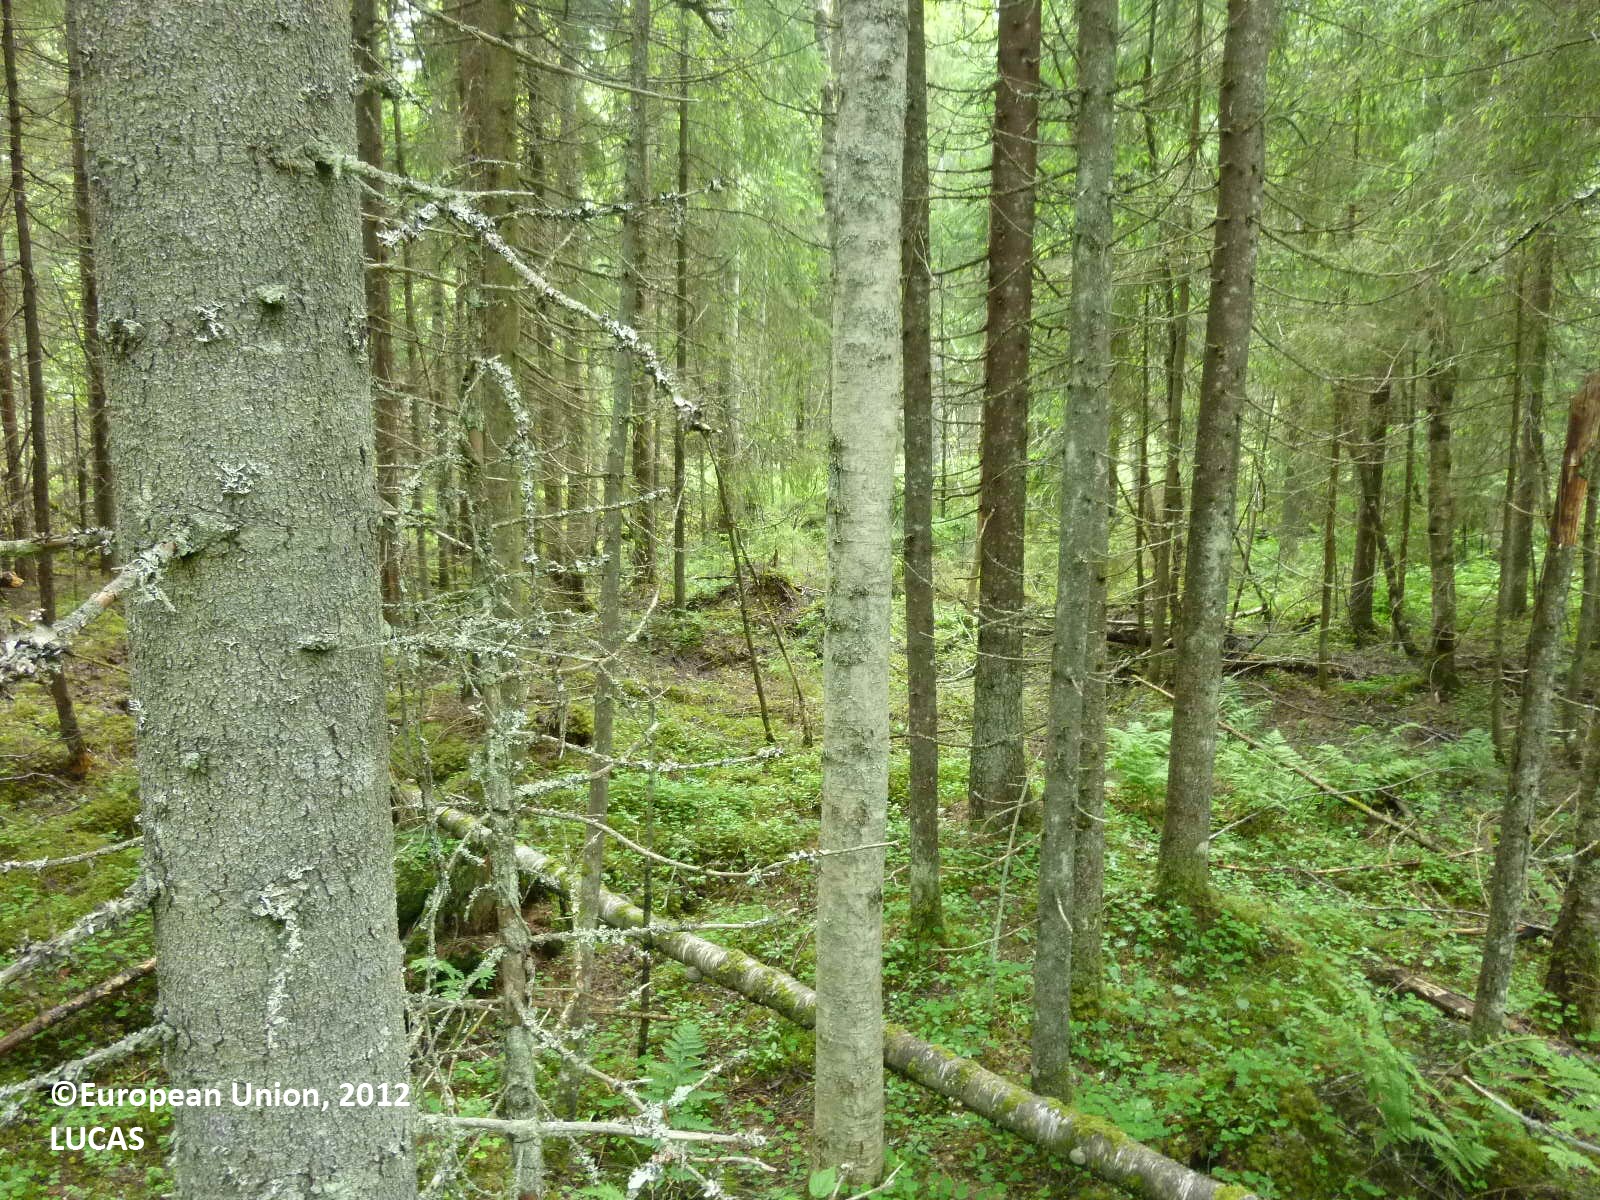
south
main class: Woodland
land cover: Spruce dominated mixed woodland
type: boreal forest
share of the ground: > 75 %
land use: Forestry
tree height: > 5 m
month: June
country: FI
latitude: 61.6979
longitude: 22.3685
